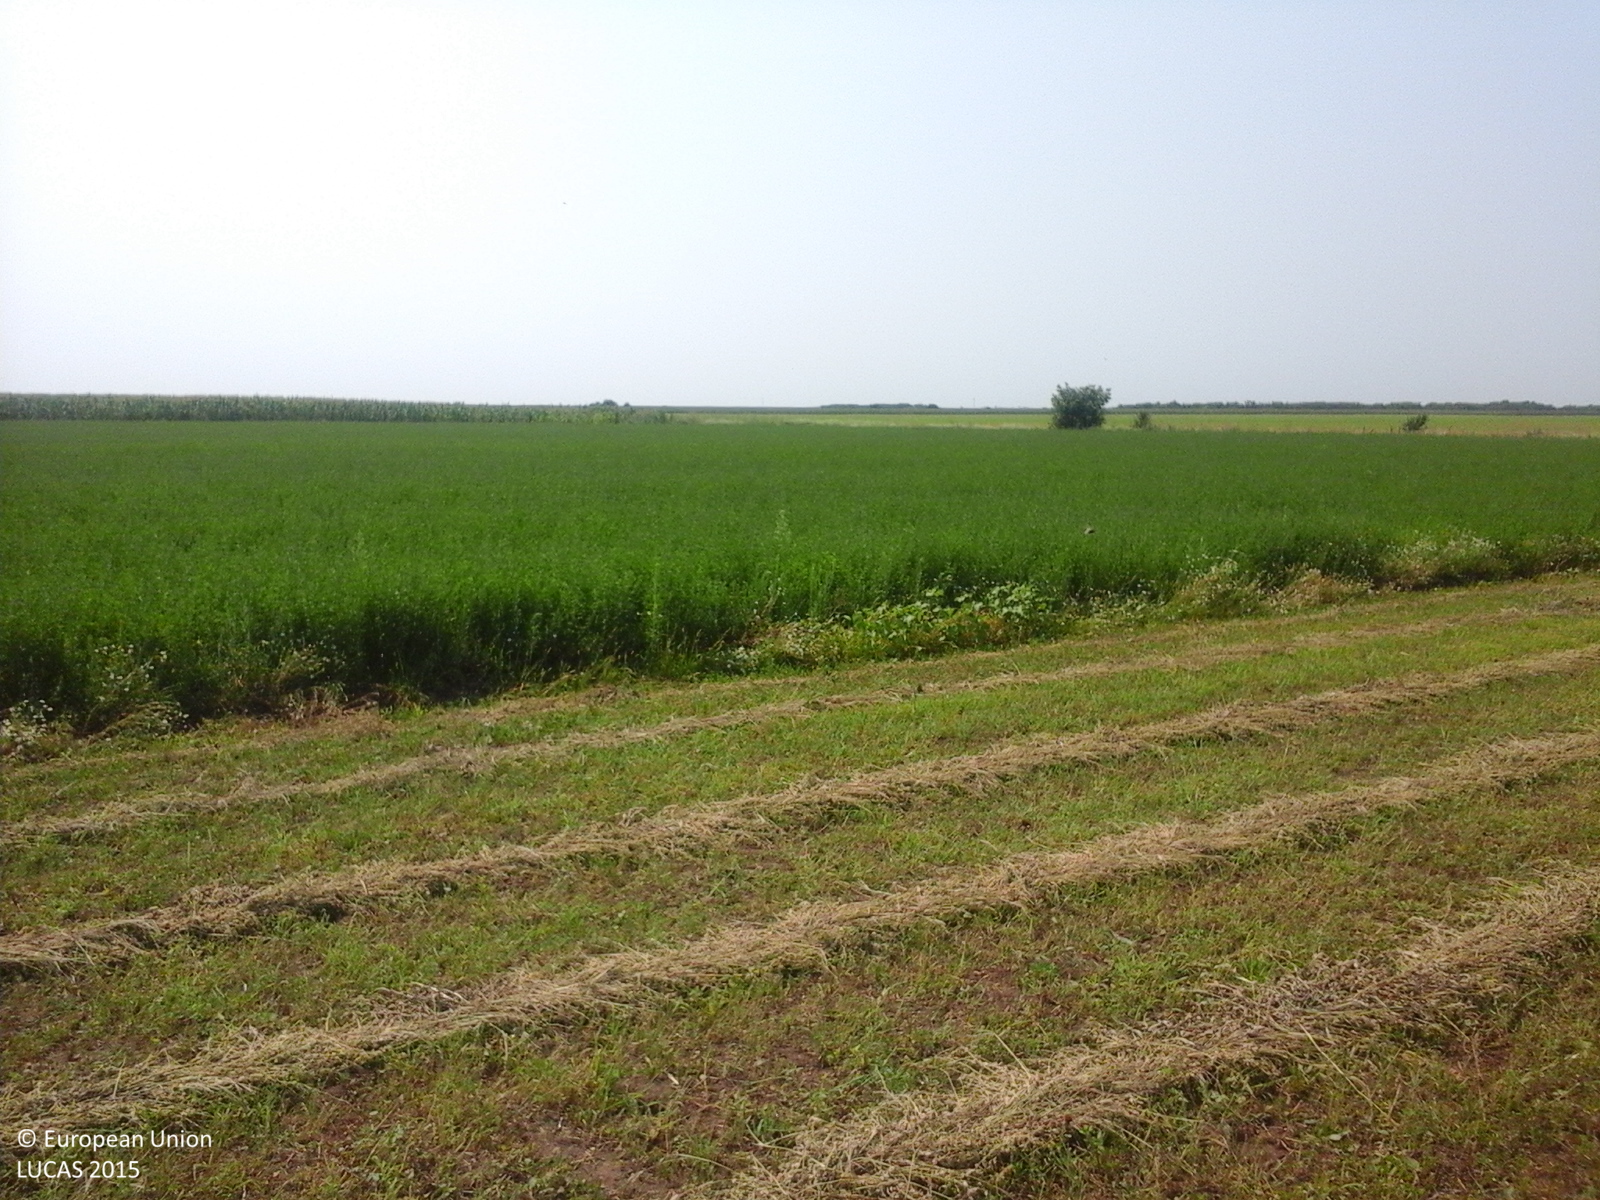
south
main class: Cropland
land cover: Lucerne
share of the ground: > 75 %
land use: Agriculture (excluding fallow land and kitchen gardens)
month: July
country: RO
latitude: 44.8163
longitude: 26.5207
